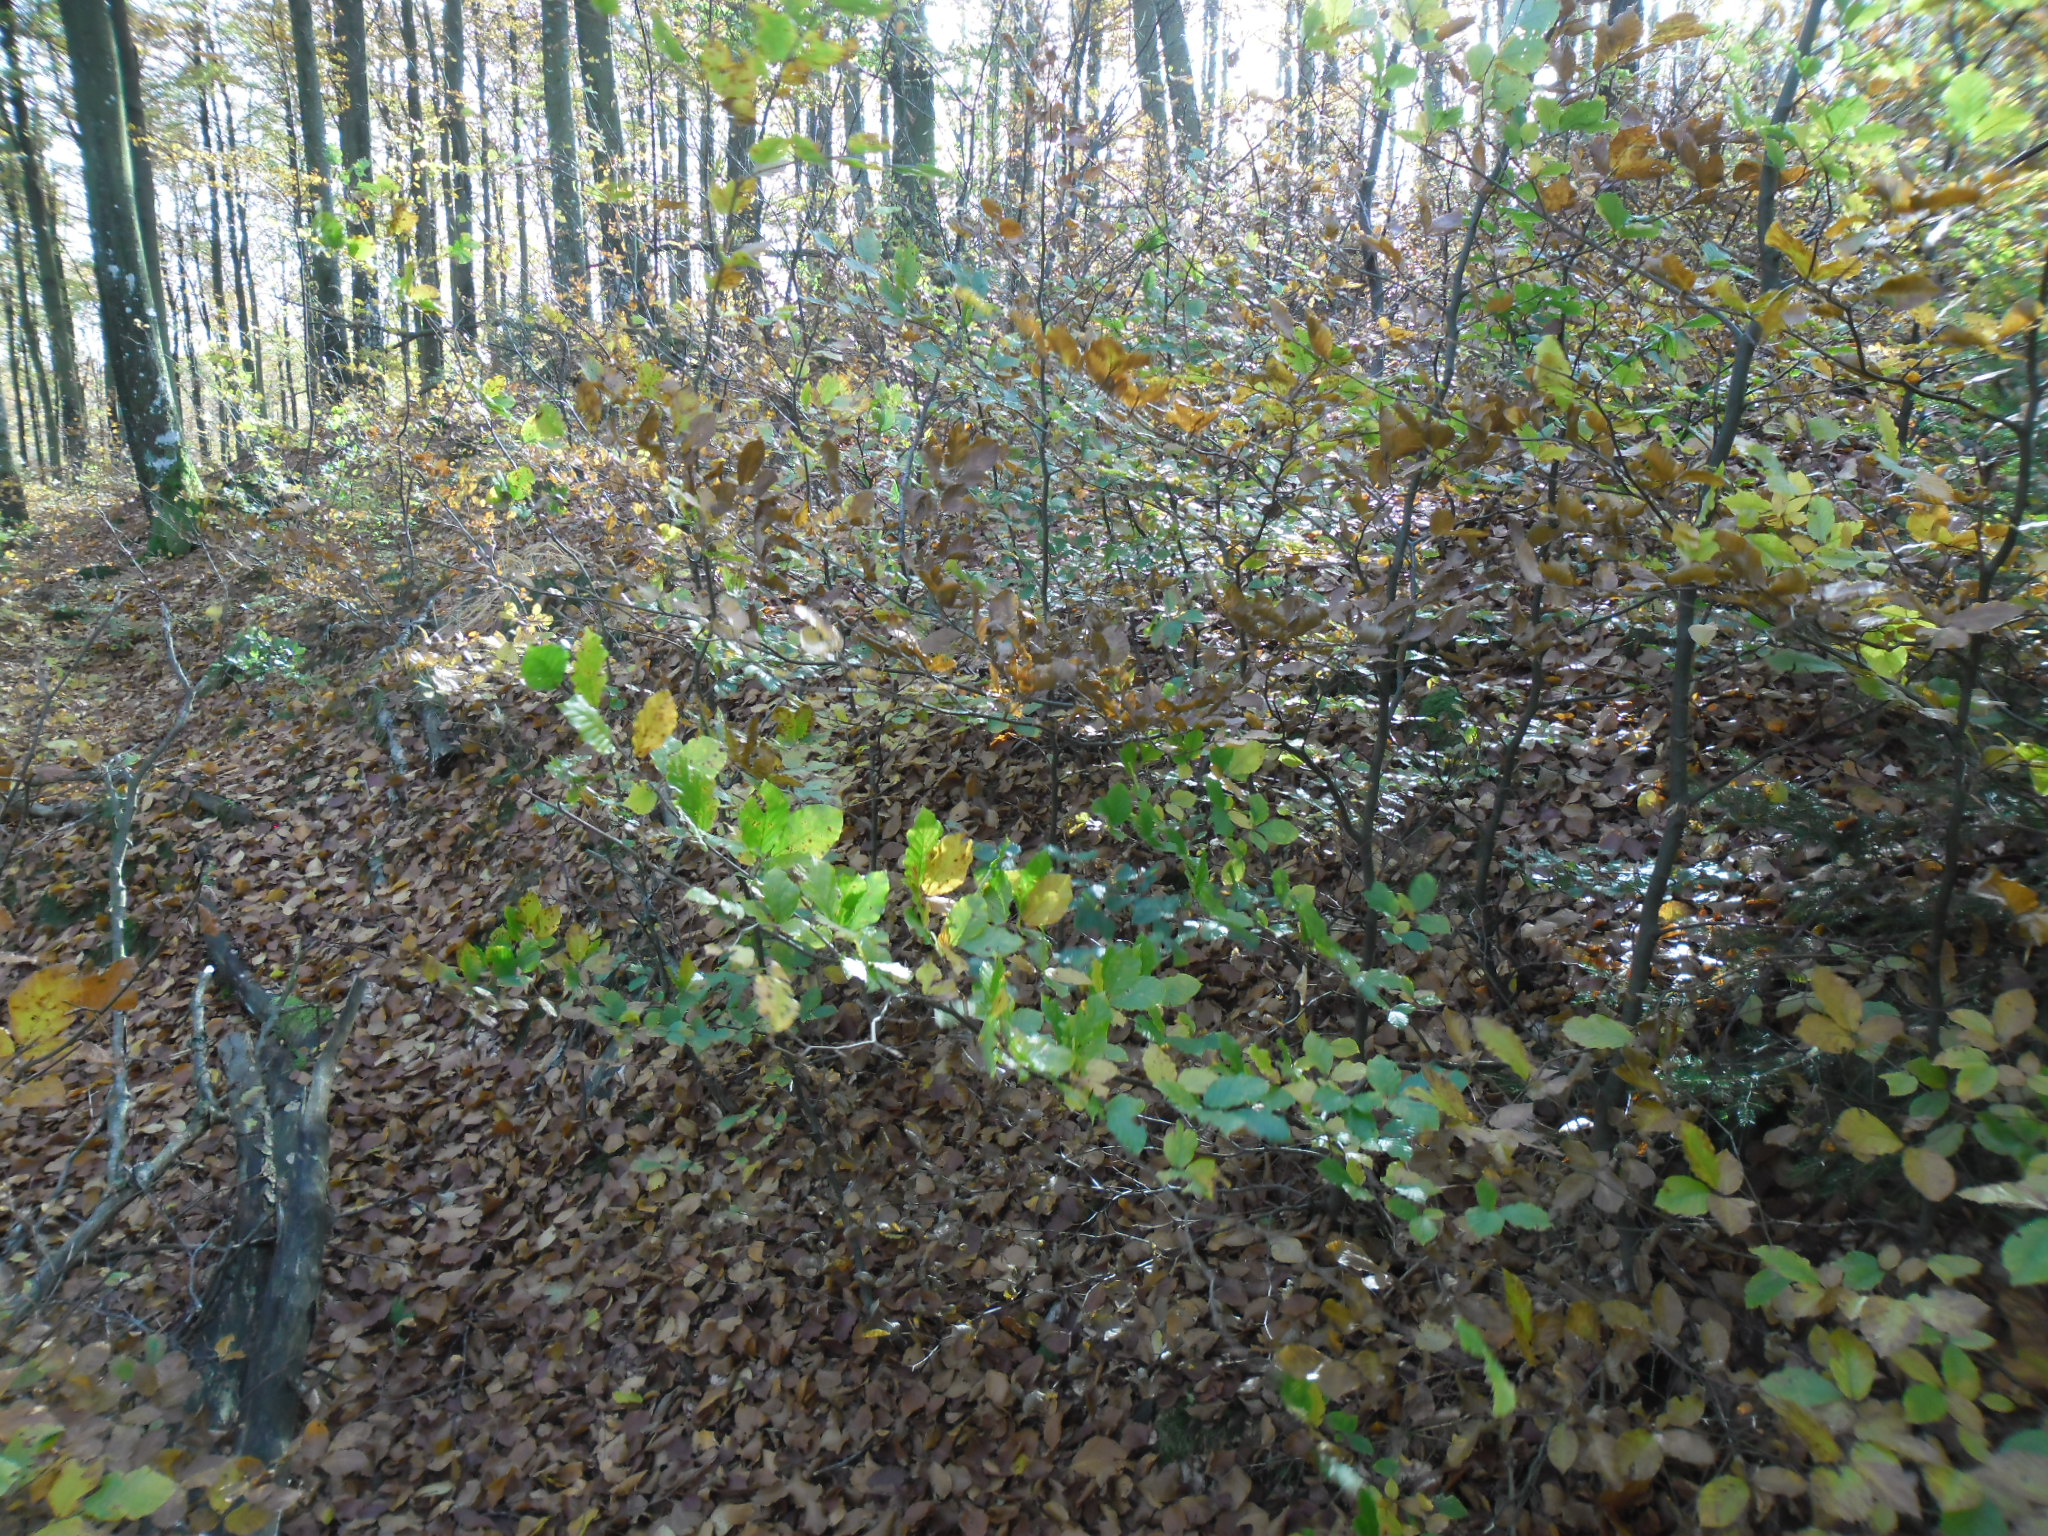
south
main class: Woodland
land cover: Broadleaved woodland
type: beech forest
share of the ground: > 75 %
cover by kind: broadleaved forest trees 80 %, herbaceous plants 20 %
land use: Forestry
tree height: > 5 m
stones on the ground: > 50 %
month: October
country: SE
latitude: 56.3665
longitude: 13.0892
